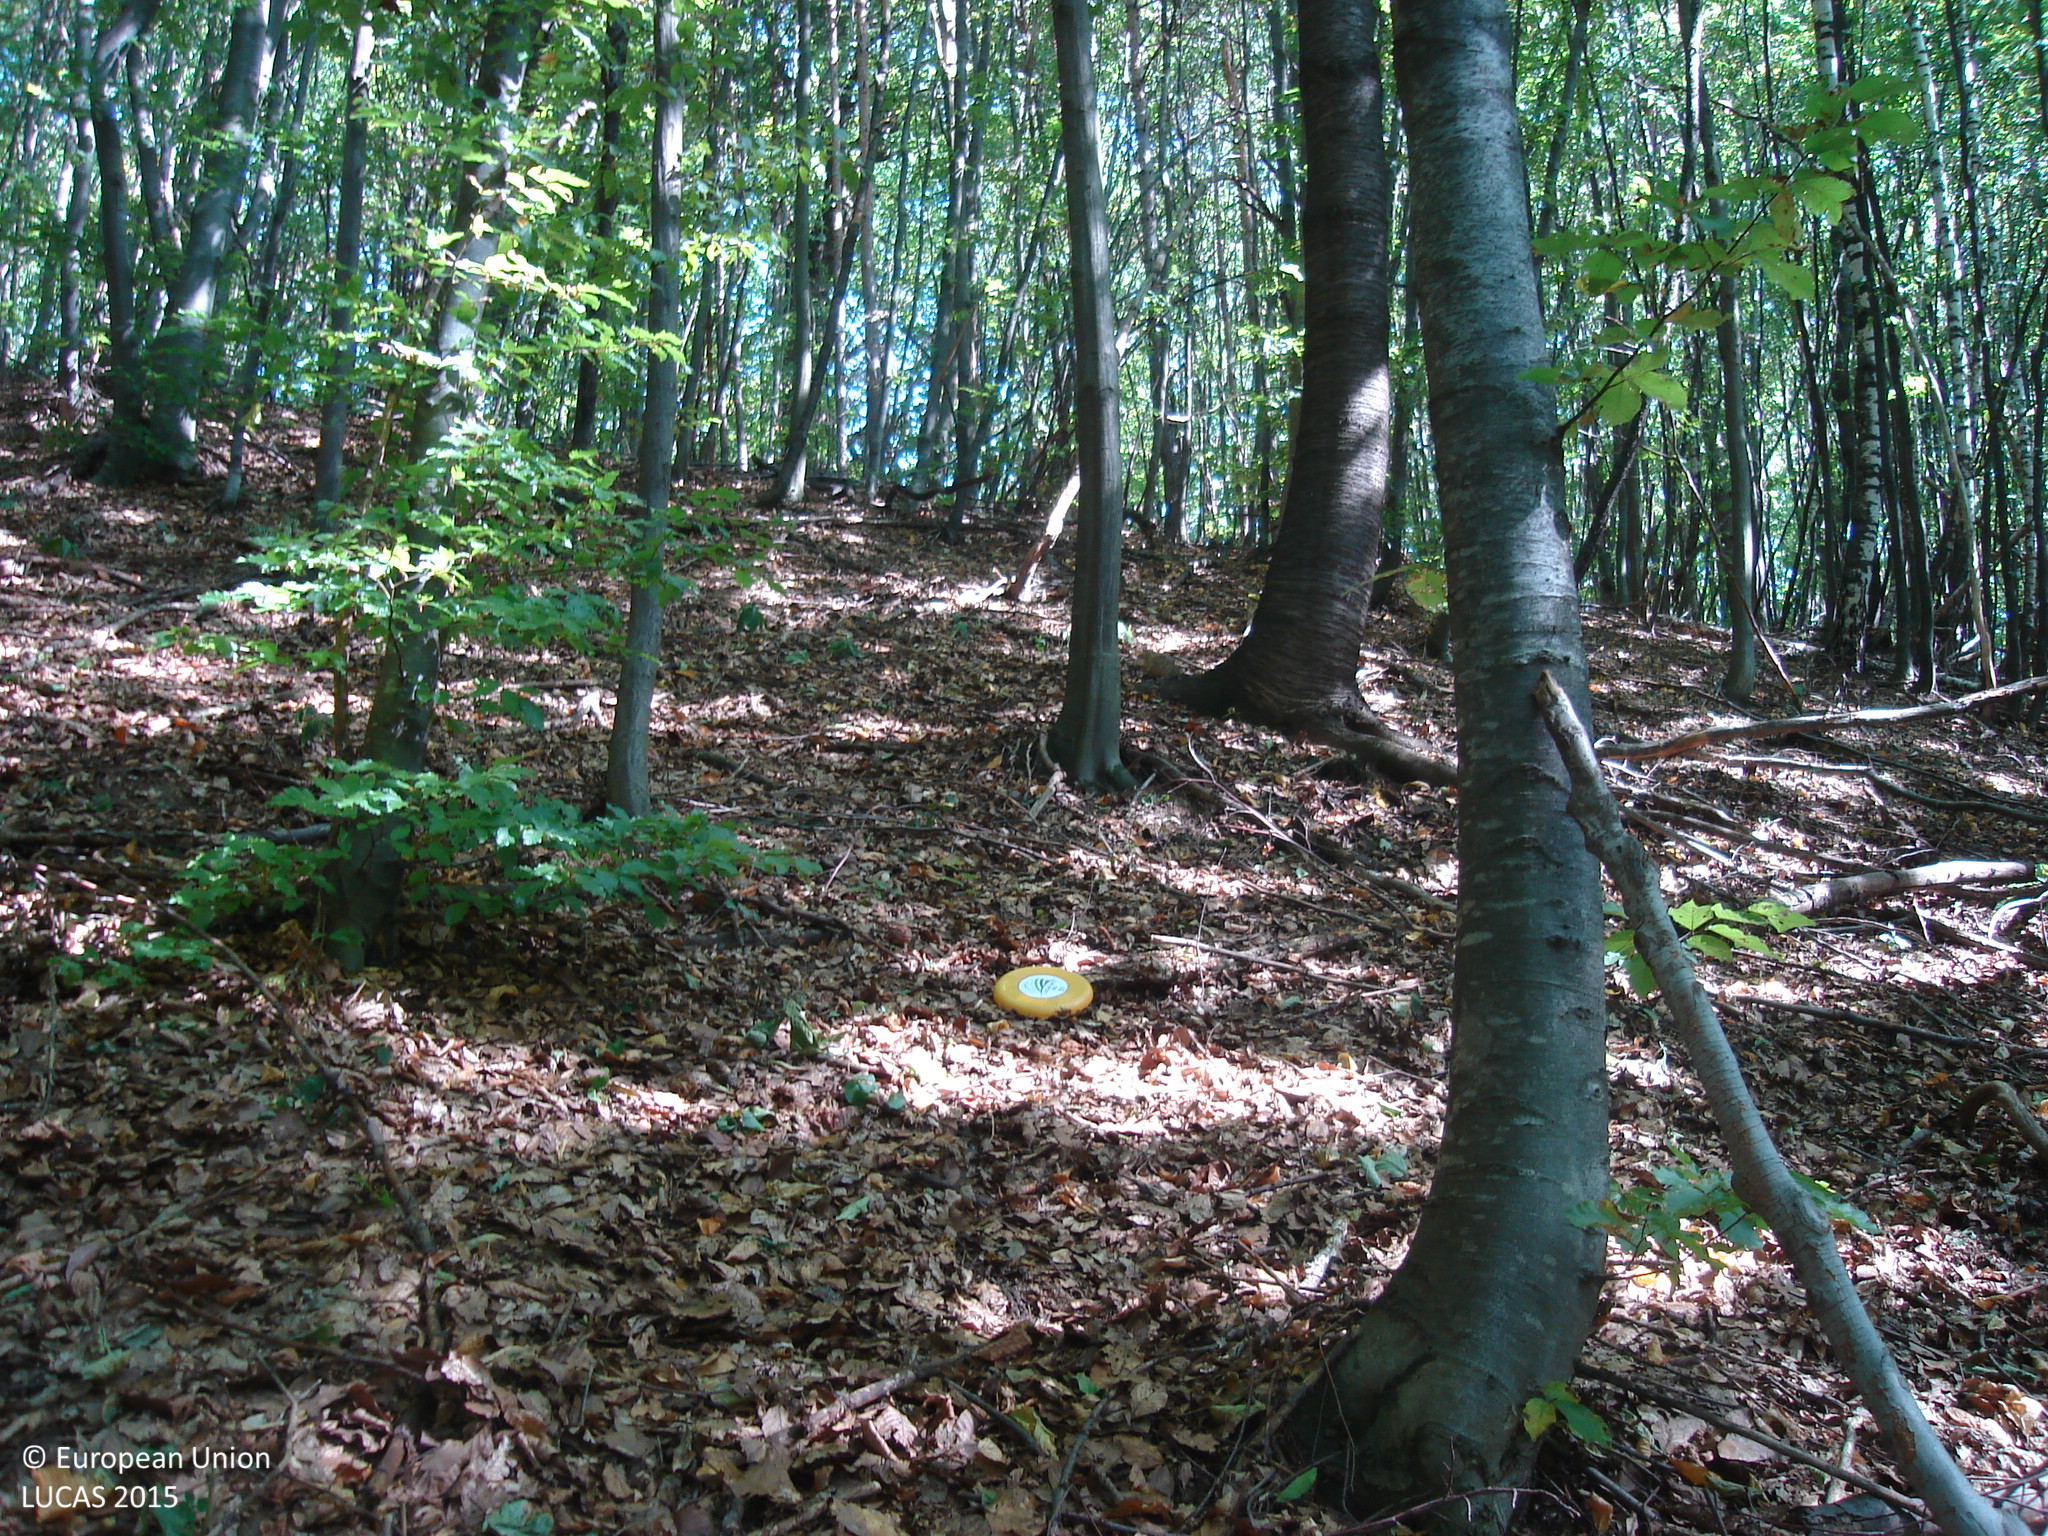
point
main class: Woodland
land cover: Broadleaved woodland
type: beech forest
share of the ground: > 75 %
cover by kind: broadleaved forest trees 80 %, consolidated bare surface 20 %
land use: Forestry
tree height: > 5 m
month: September
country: BG
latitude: 42.8108
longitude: 23.9995
